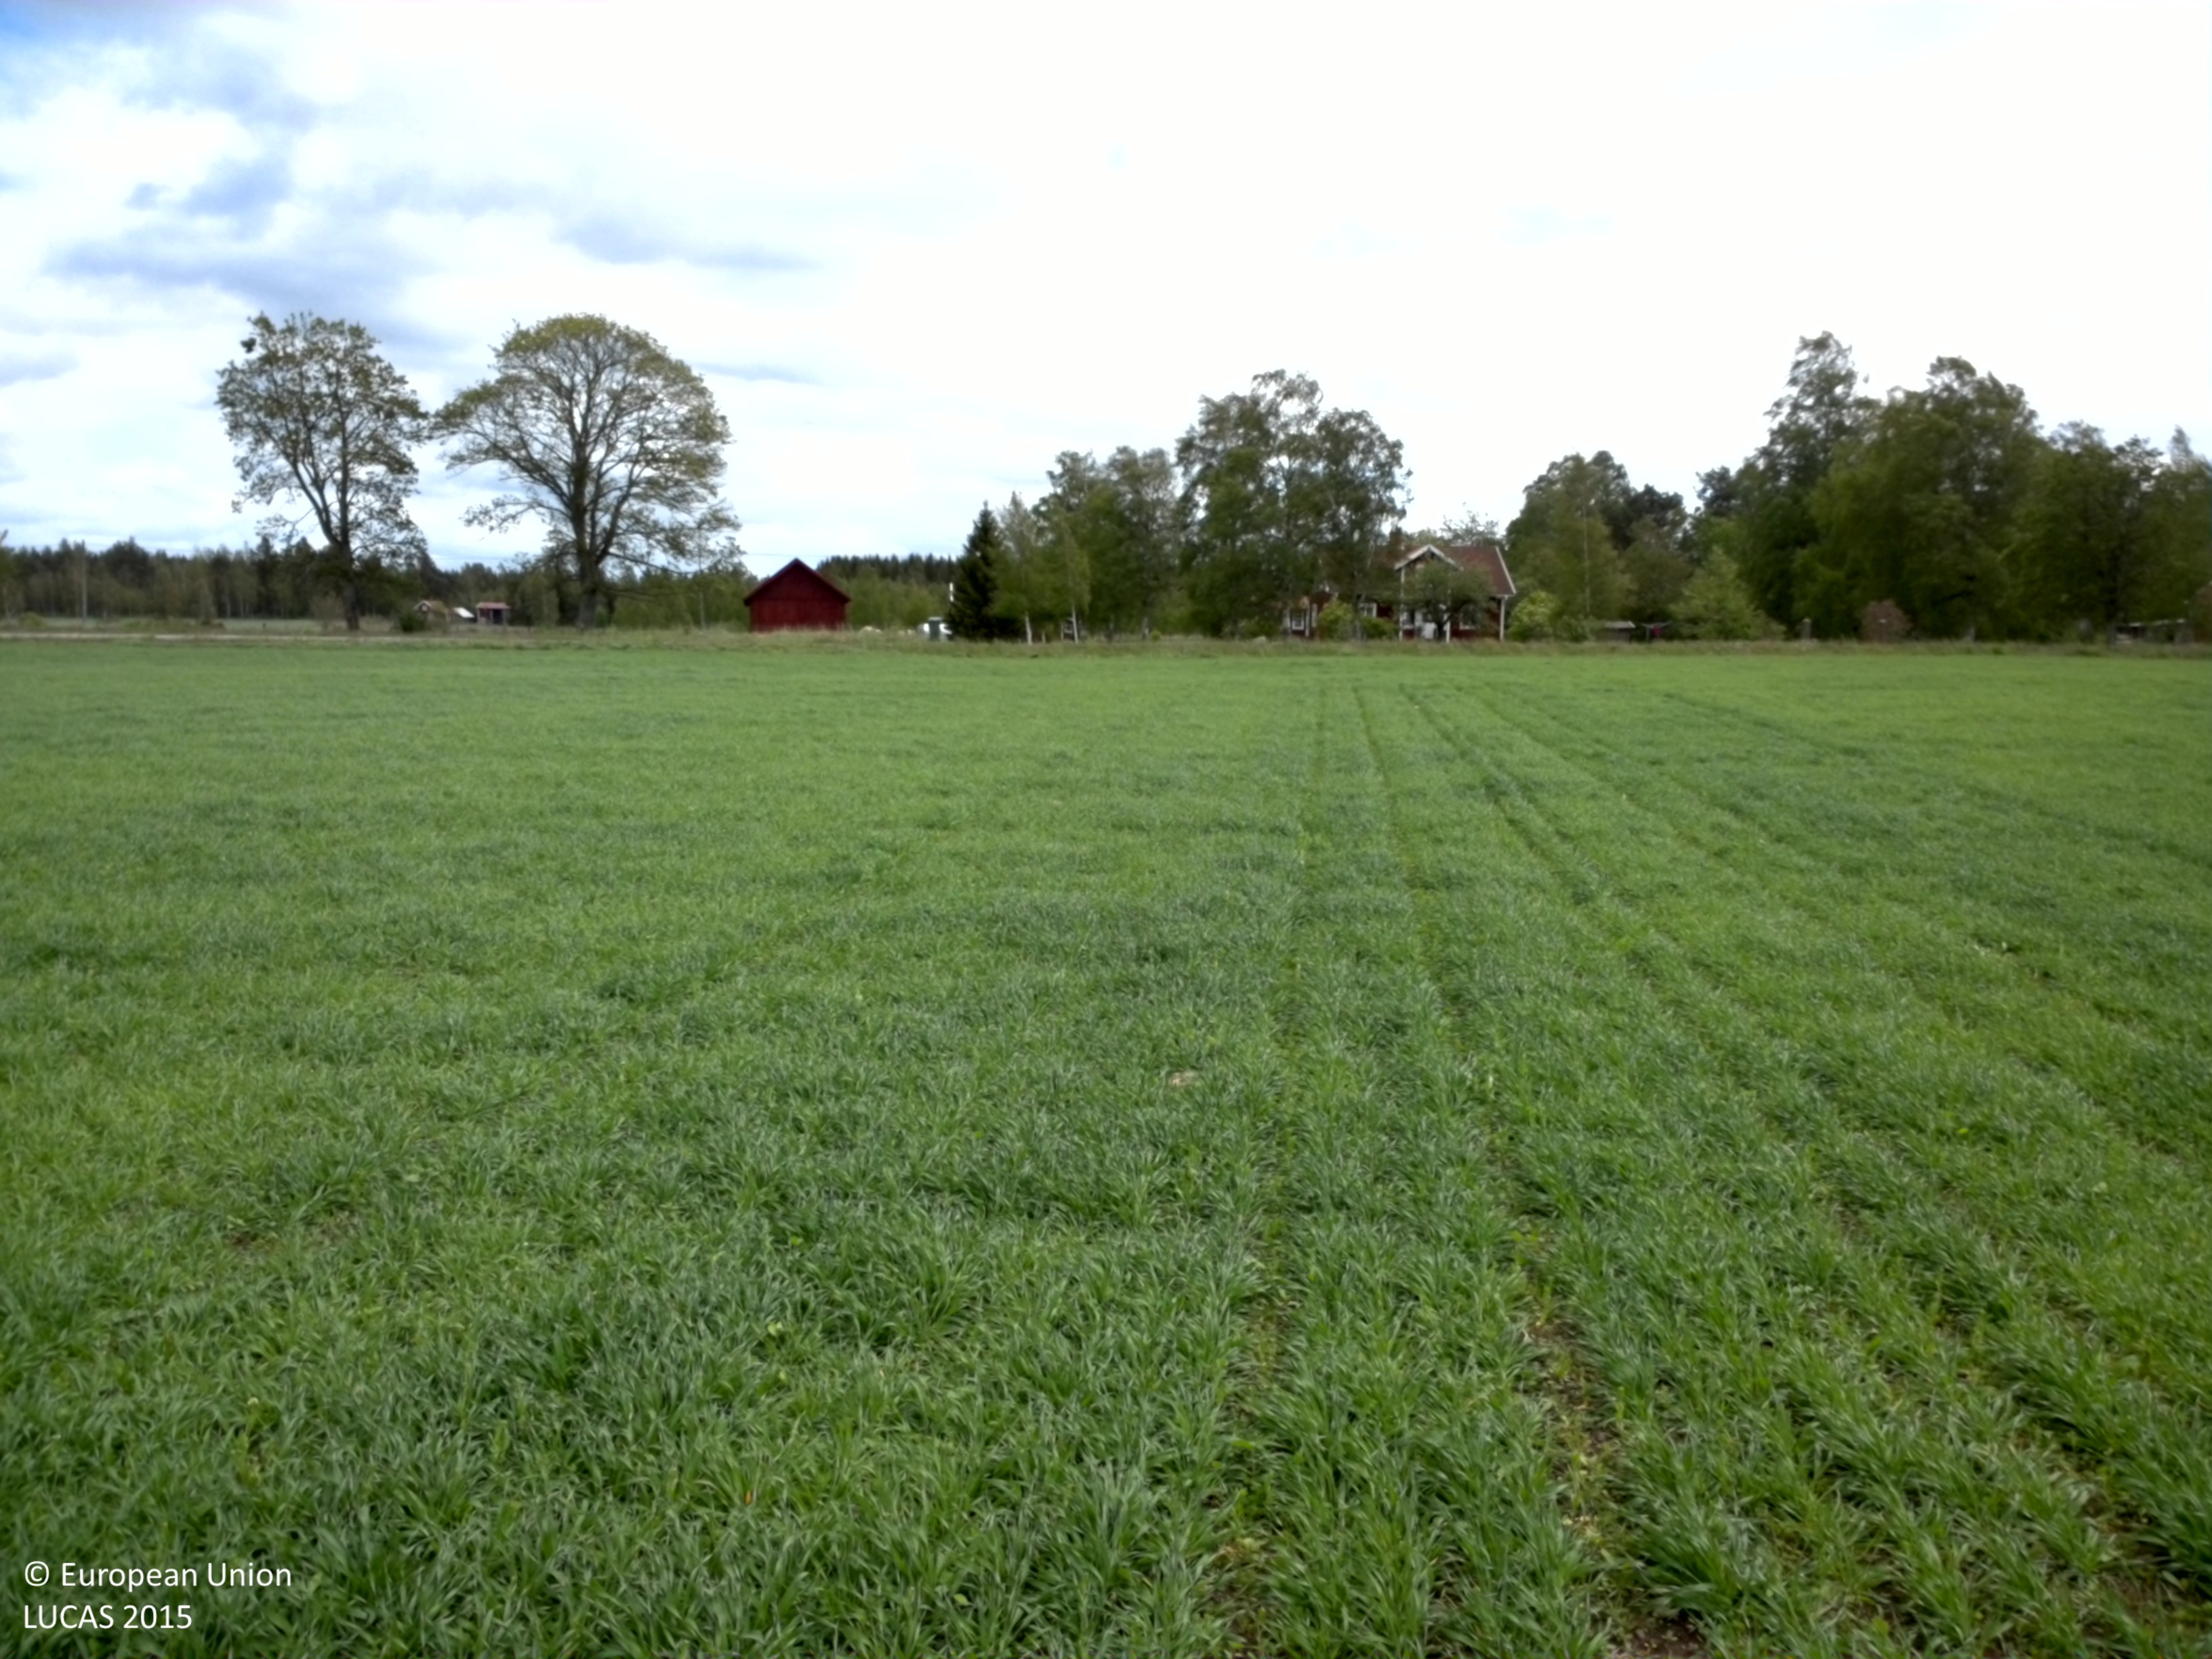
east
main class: Cropland
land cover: Barley
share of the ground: > 75 %
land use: Agriculture (excluding fallow land and kitchen gardens)
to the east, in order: Barley; Ditches and canals; Paved roads, cycling and walking lanes; Artificial constructions in urban areas; Fences; Grassland without tree/shrub cover
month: June
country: SE
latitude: 58.3230
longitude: 13.9720
